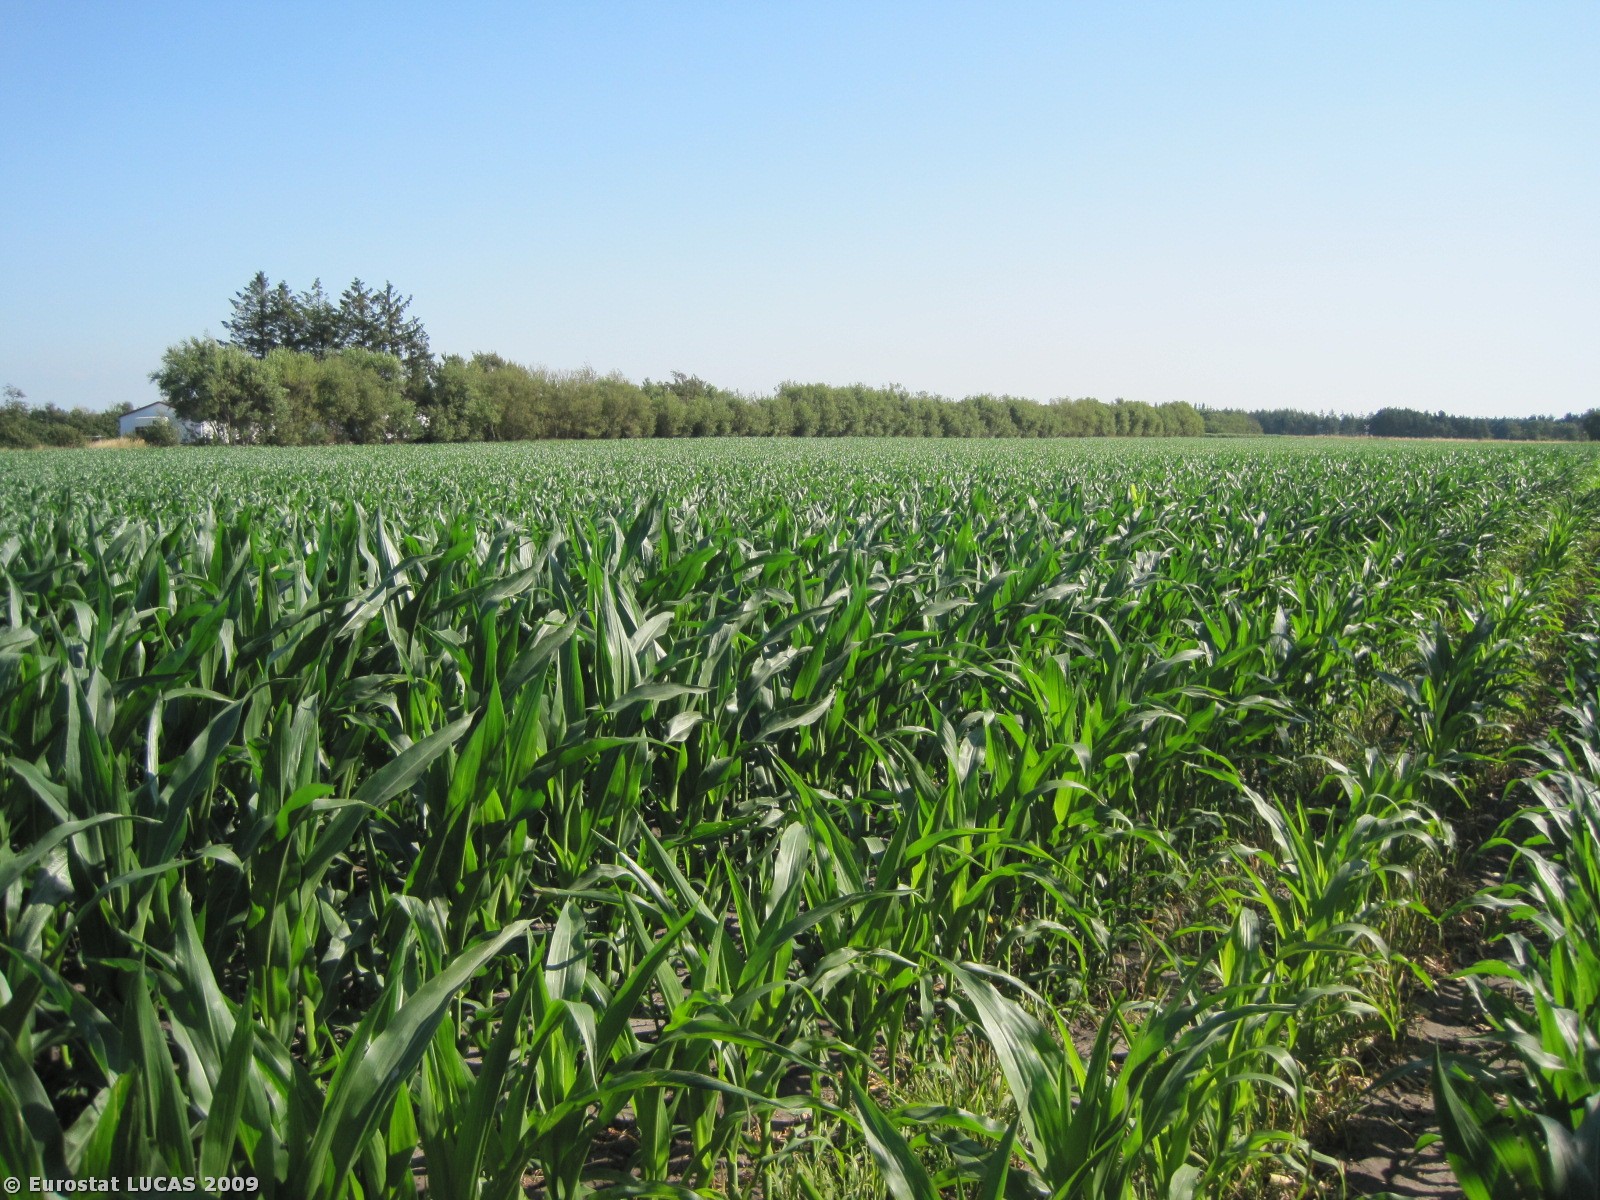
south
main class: Woodland
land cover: Broadleaved woodland
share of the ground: 25 - 50 %
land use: Forestry
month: July
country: DK
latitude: 56.3767
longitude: 8.4959
